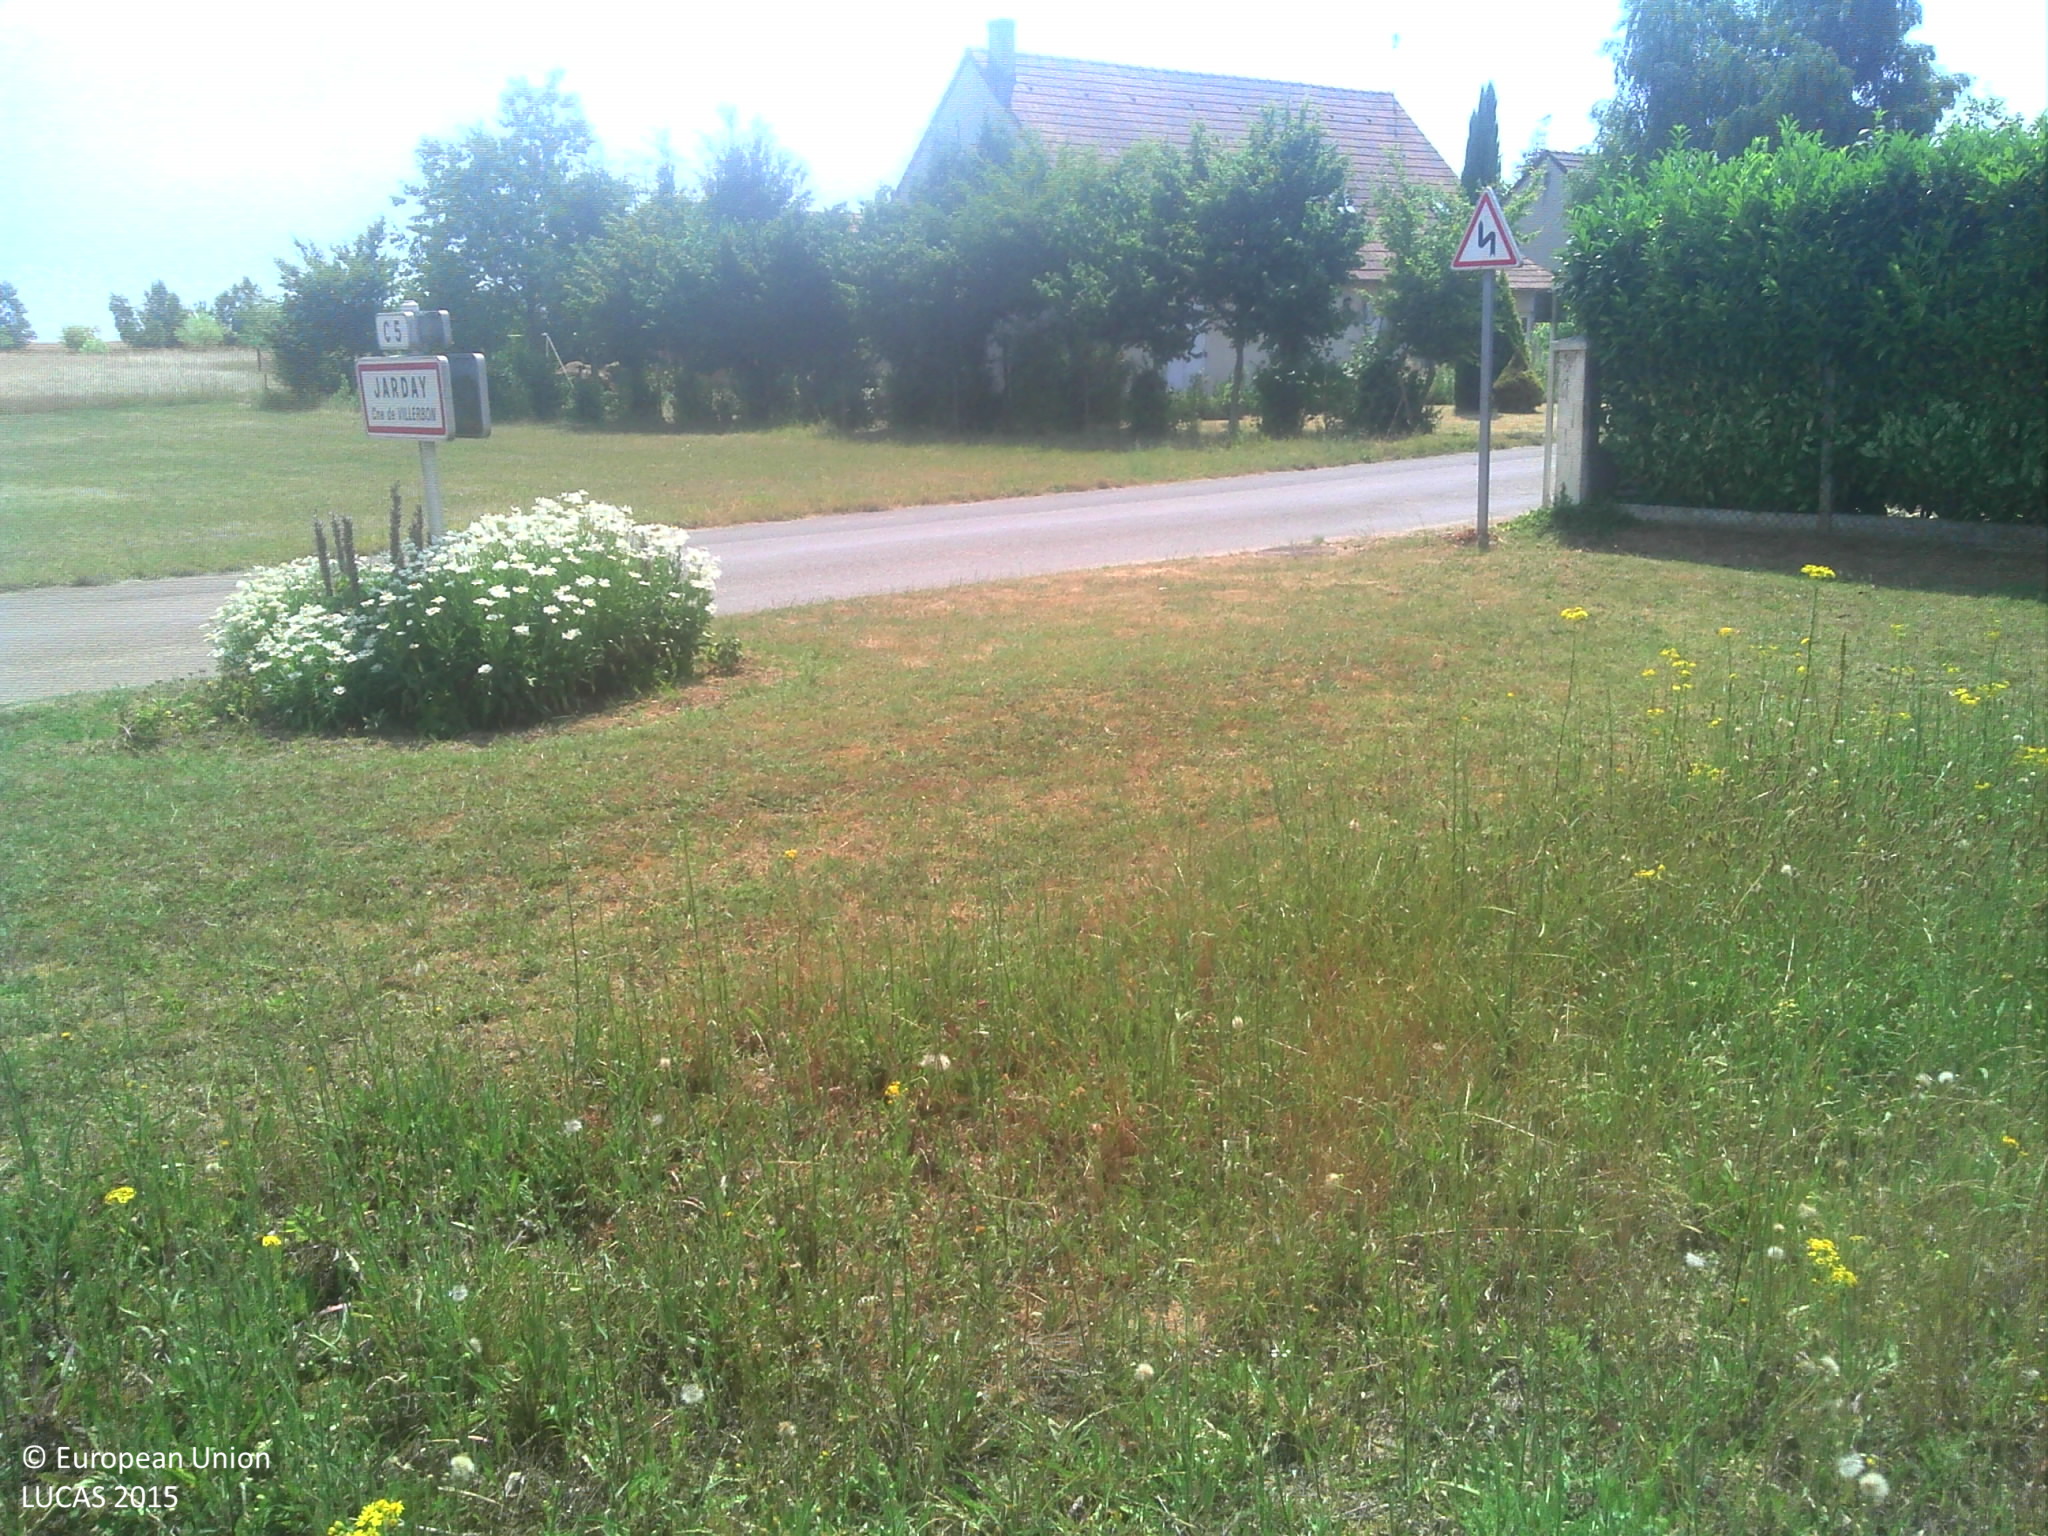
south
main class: Grassland
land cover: Spontaneously vegetated surfaces
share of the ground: > 75 %
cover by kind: herbaceous plants 100 %
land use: Agriculture (excluding fallow land and kitchen gardens)
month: July
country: FR
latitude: 47.6474
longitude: 1.3448
